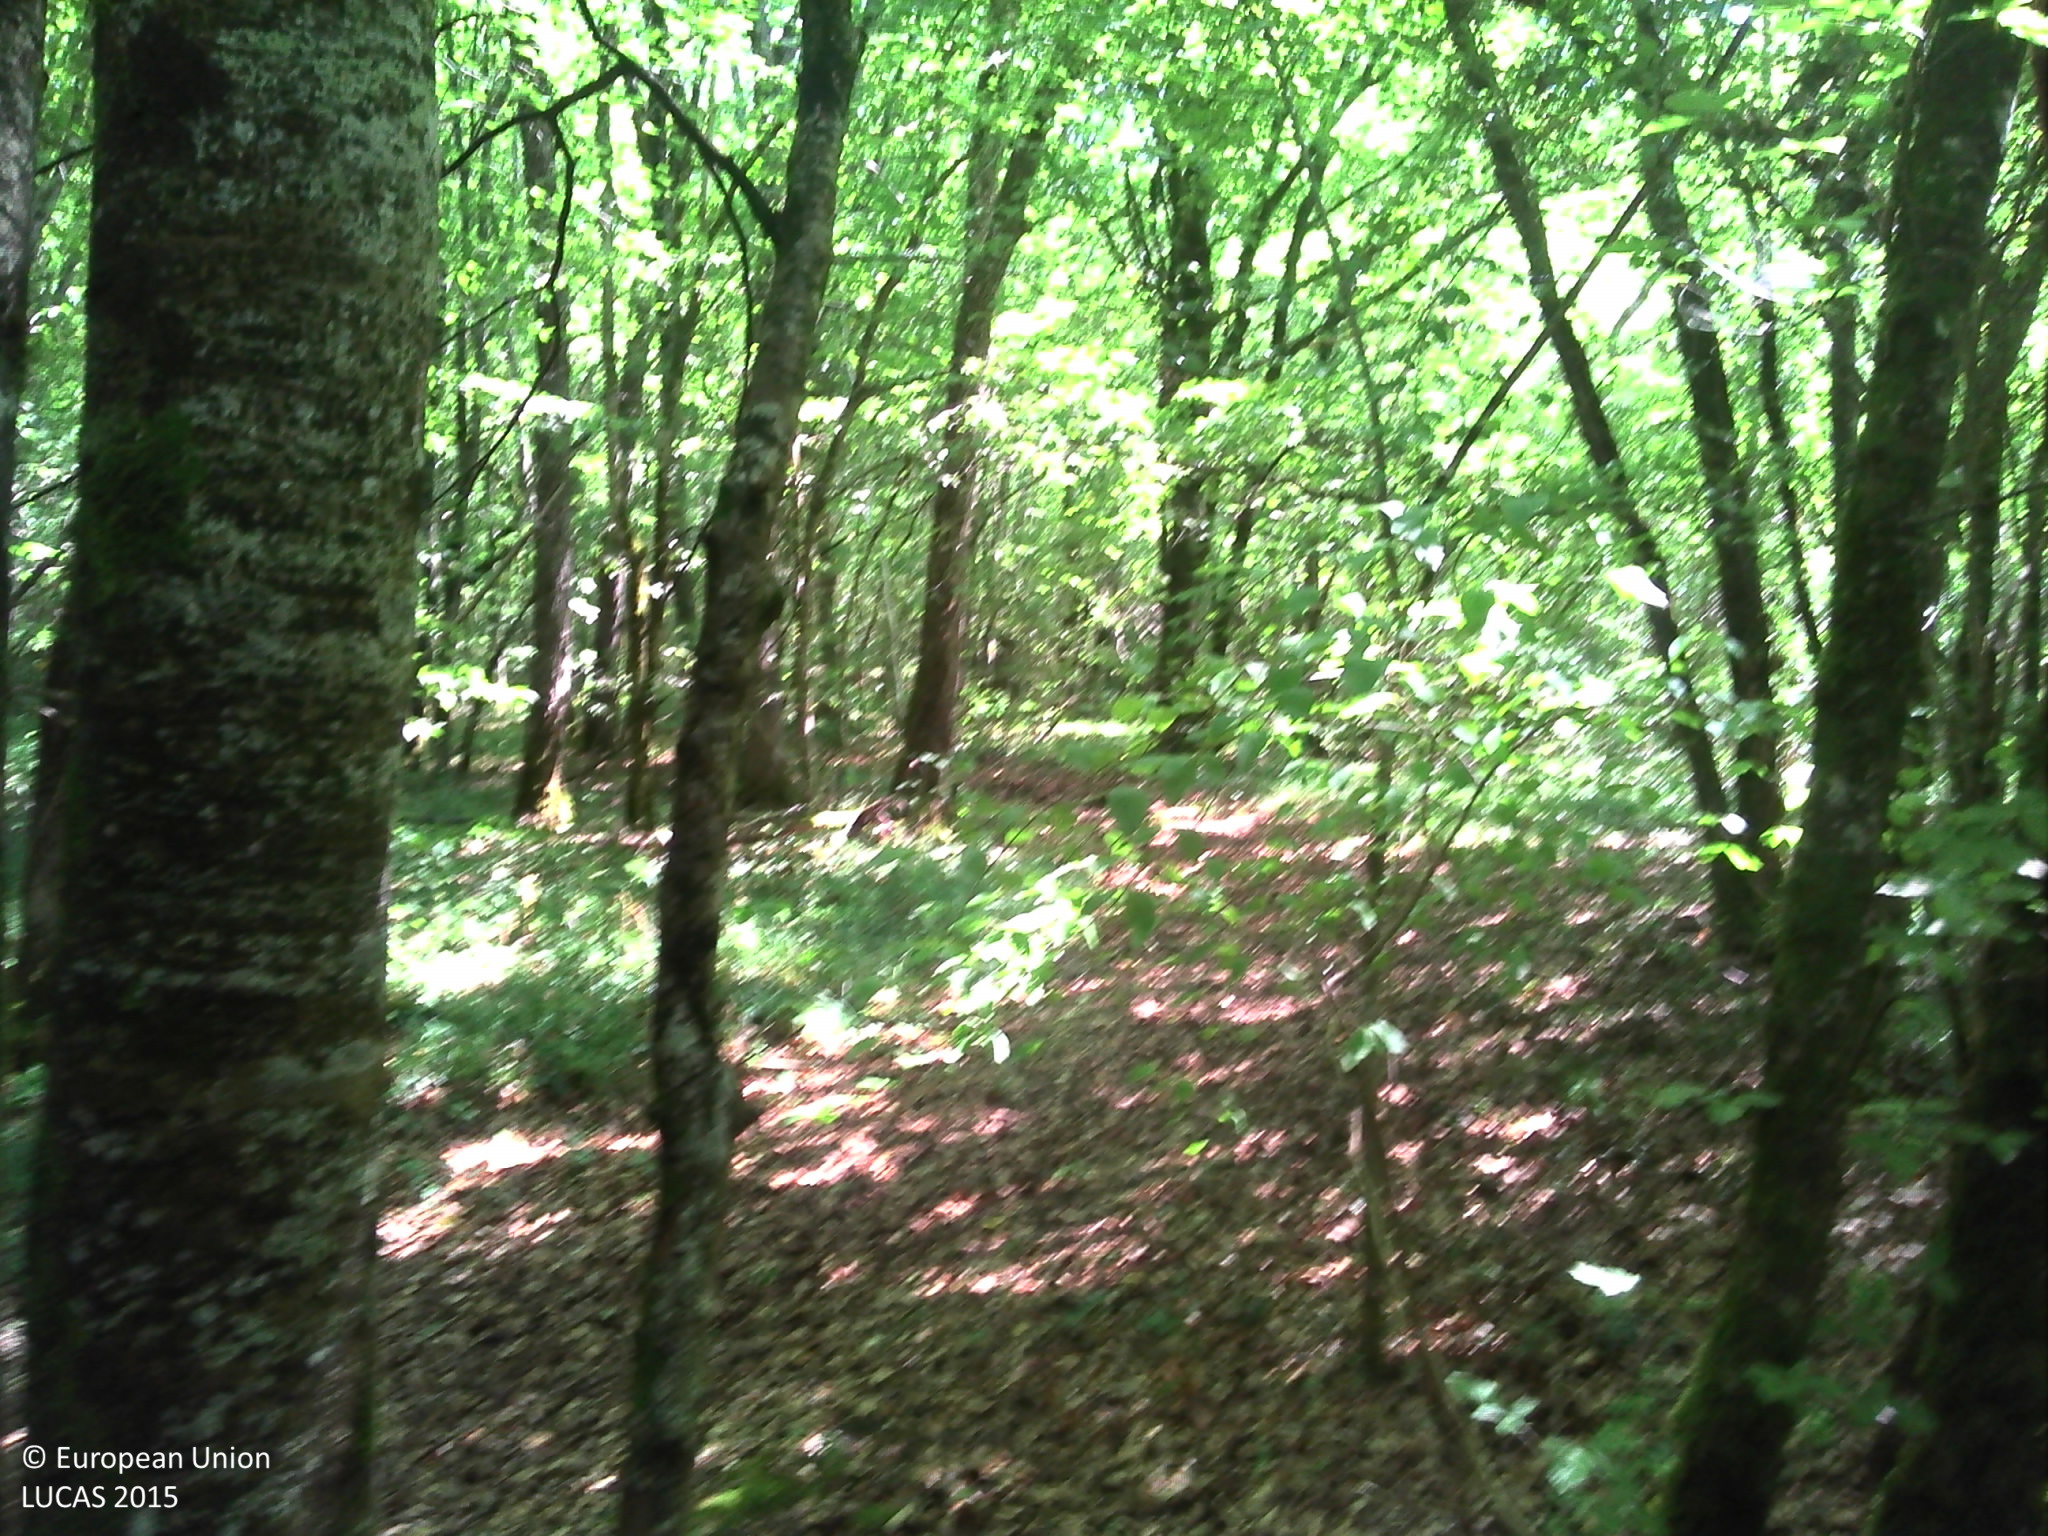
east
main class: Woodland
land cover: Broadleaved woodland
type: acidophilous oak and oak-birch forest
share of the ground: > 75 %
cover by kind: broadleaved forest trees 80 %, herbaceous plants 10 %, lichens and mosses 10 %
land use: Forestry
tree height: > 5 m
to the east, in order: Broadleaved woodland; Tracks; Broadleaved woodland
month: July
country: FR
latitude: 48.0304
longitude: 4.8357
